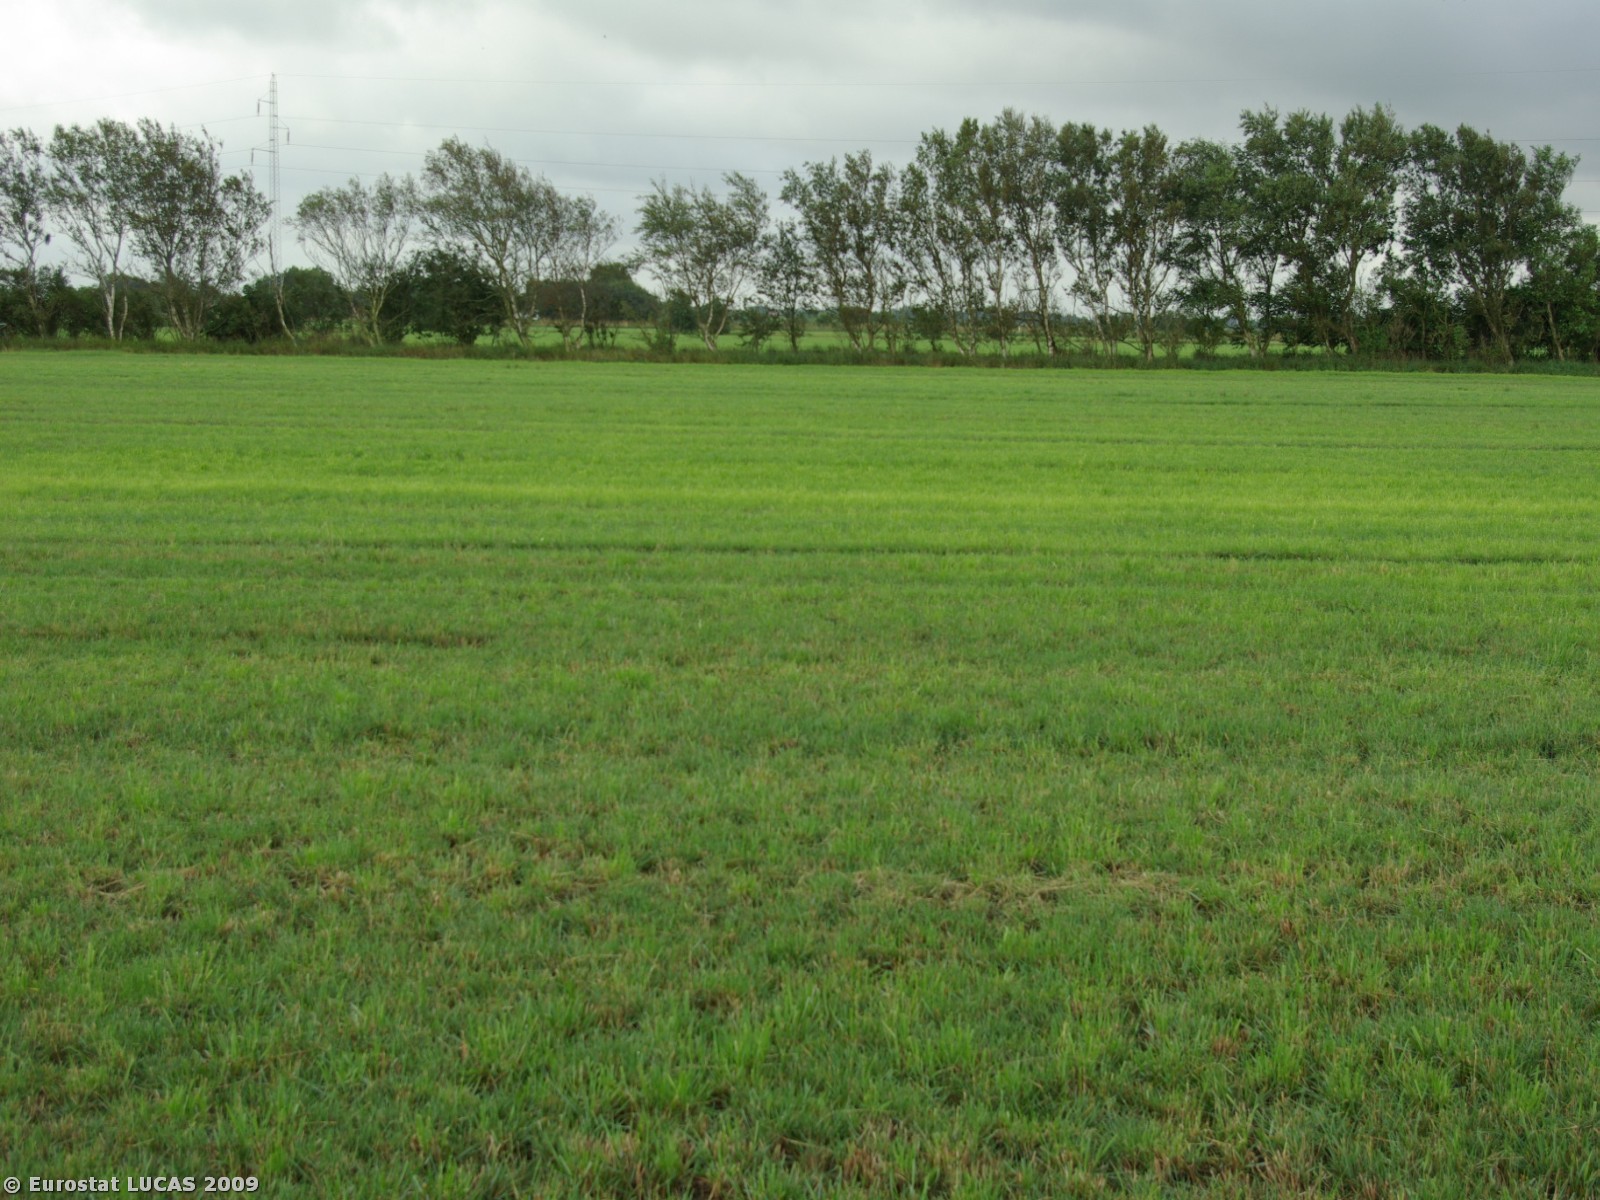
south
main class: Grassland
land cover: Grassland without tree/shrub cover
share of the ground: > 75 %
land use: Agriculture (excluding fallow land and kitchen gardens)
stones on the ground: < 10 %
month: July
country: DK
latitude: 54.9241
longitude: 8.8306
